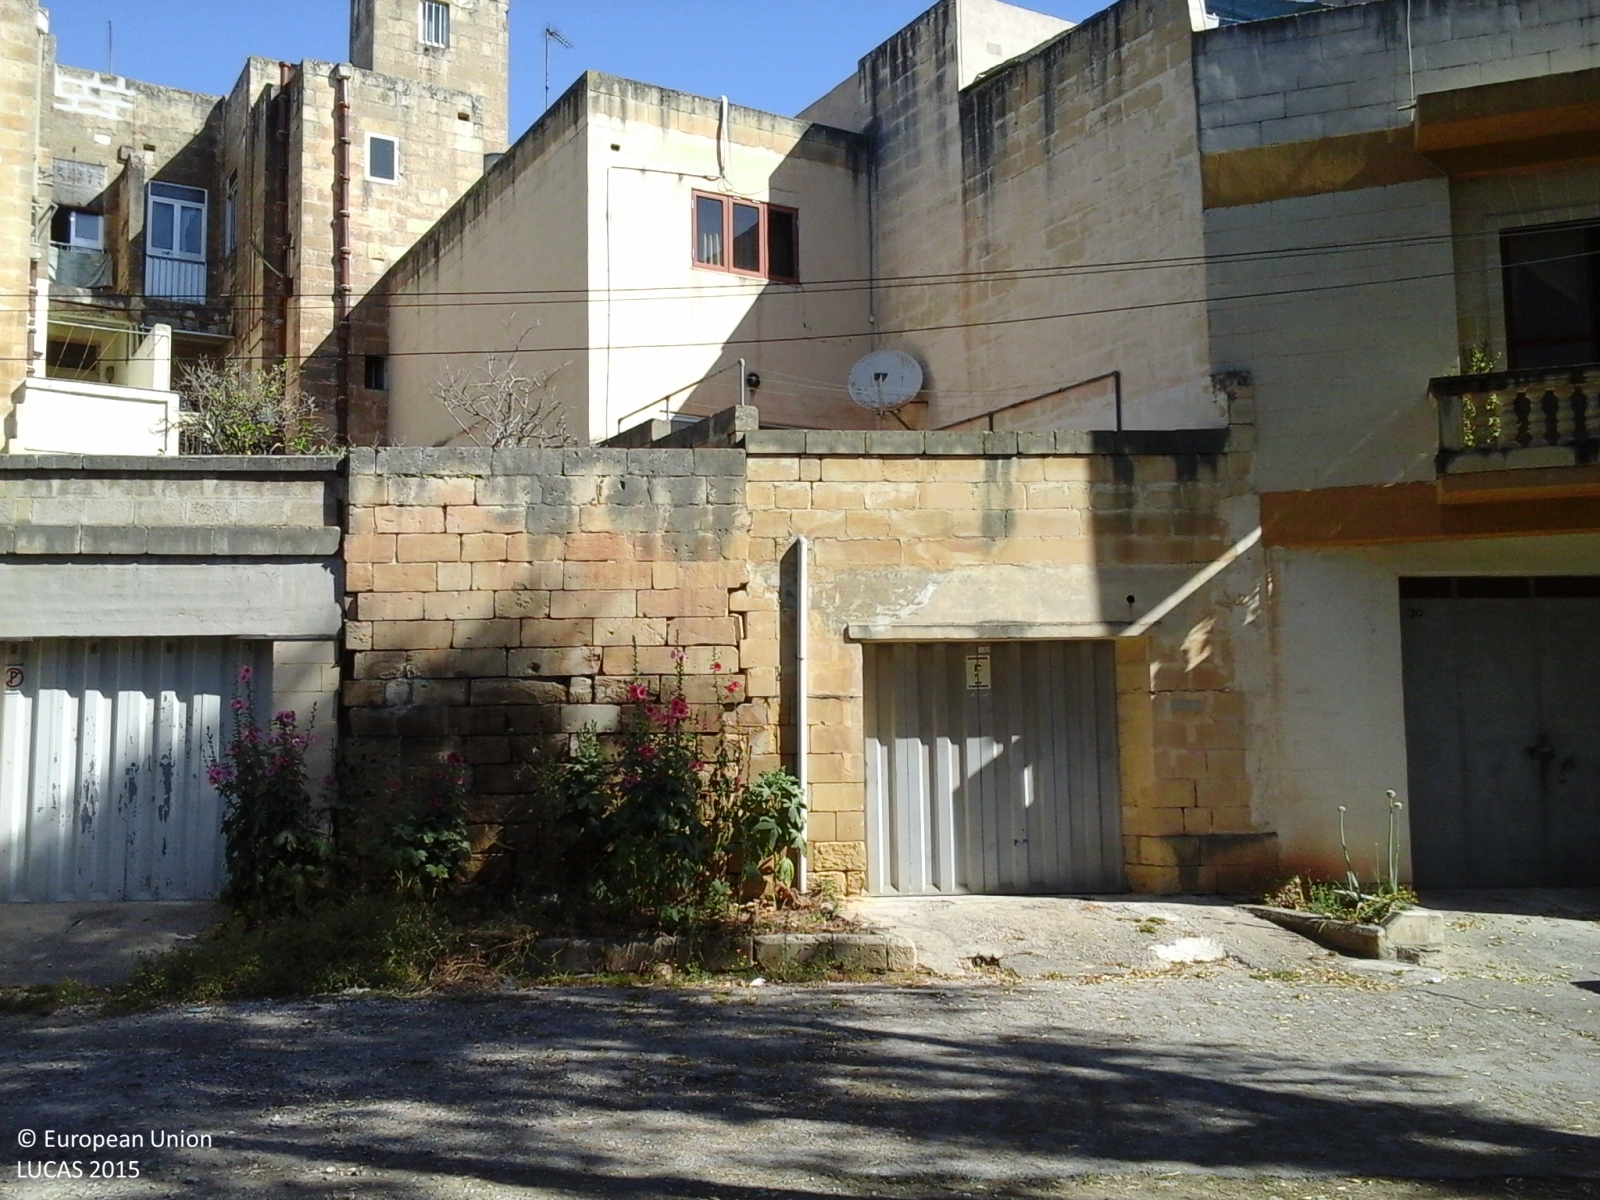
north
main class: Woodland
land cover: Pine dominated coniferous woodland
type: coniferous forest of the mediterranean region
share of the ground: 50 - 75 %
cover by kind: coniferous forest trees 100 %
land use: Amenities, museums, leisure
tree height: > 5 m
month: May
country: MT
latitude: 35.8753
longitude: 14.5105
